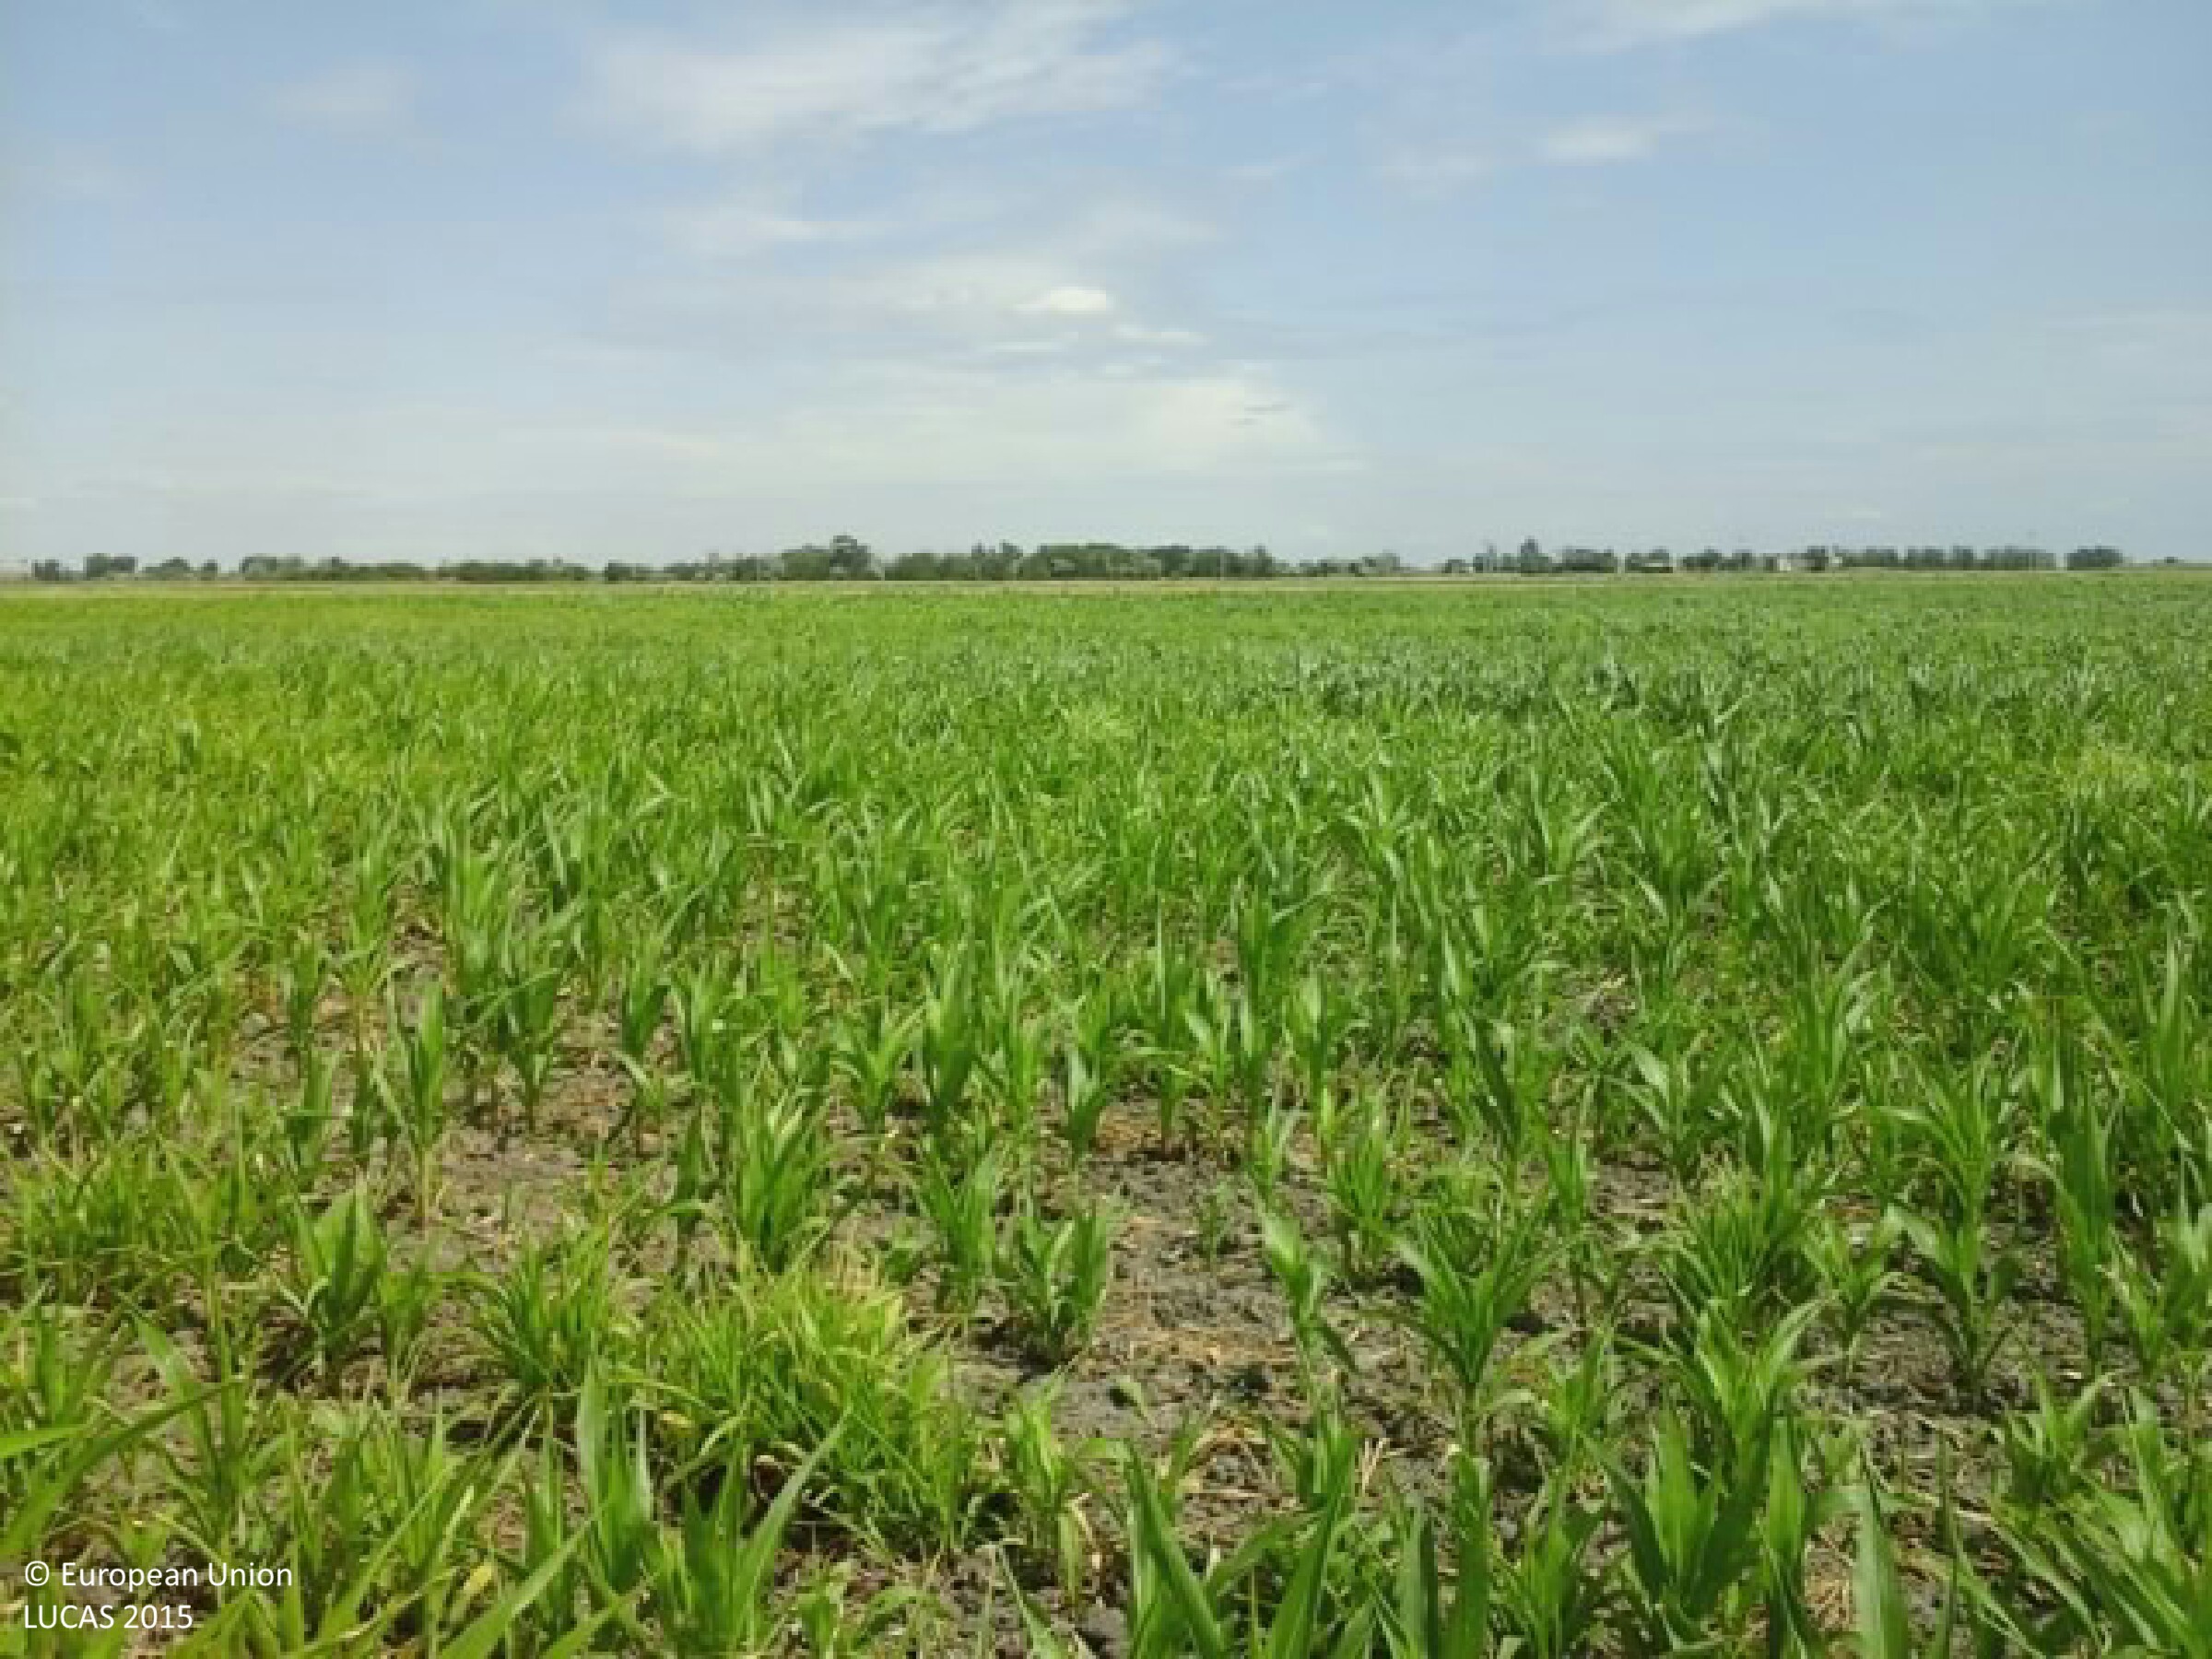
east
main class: Cropland
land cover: Maize
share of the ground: 50 - 75 %
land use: Agriculture (excluding fallow land and kitchen gardens)
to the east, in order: Maize; Grassland without tree/shrub cover
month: July
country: HU
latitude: 47.1088
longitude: 19.0431
